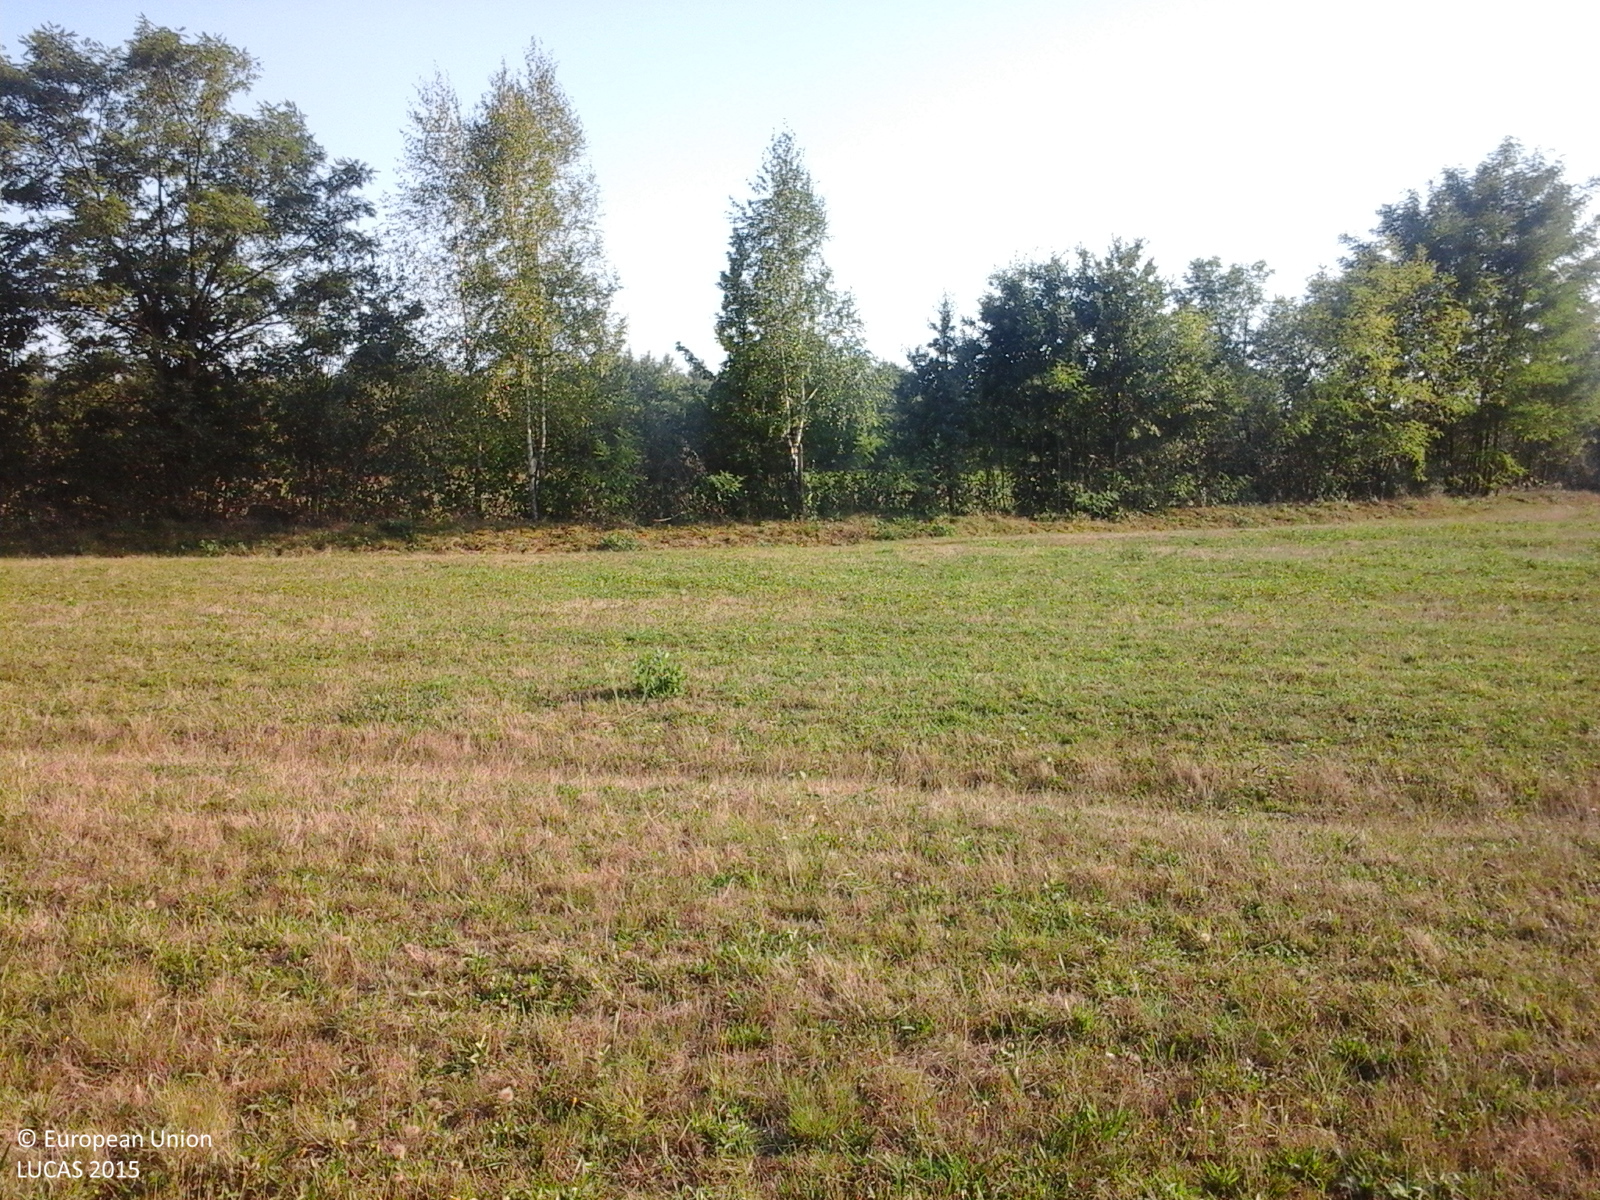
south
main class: Grassland
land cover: Grassland without tree/shrub cover
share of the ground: > 75 %
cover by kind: herbaceous plants 100 %
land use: Agriculture (excluding fallow land and kitchen gardens)
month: September
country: RO
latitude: 46.6968
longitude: 22.4360
